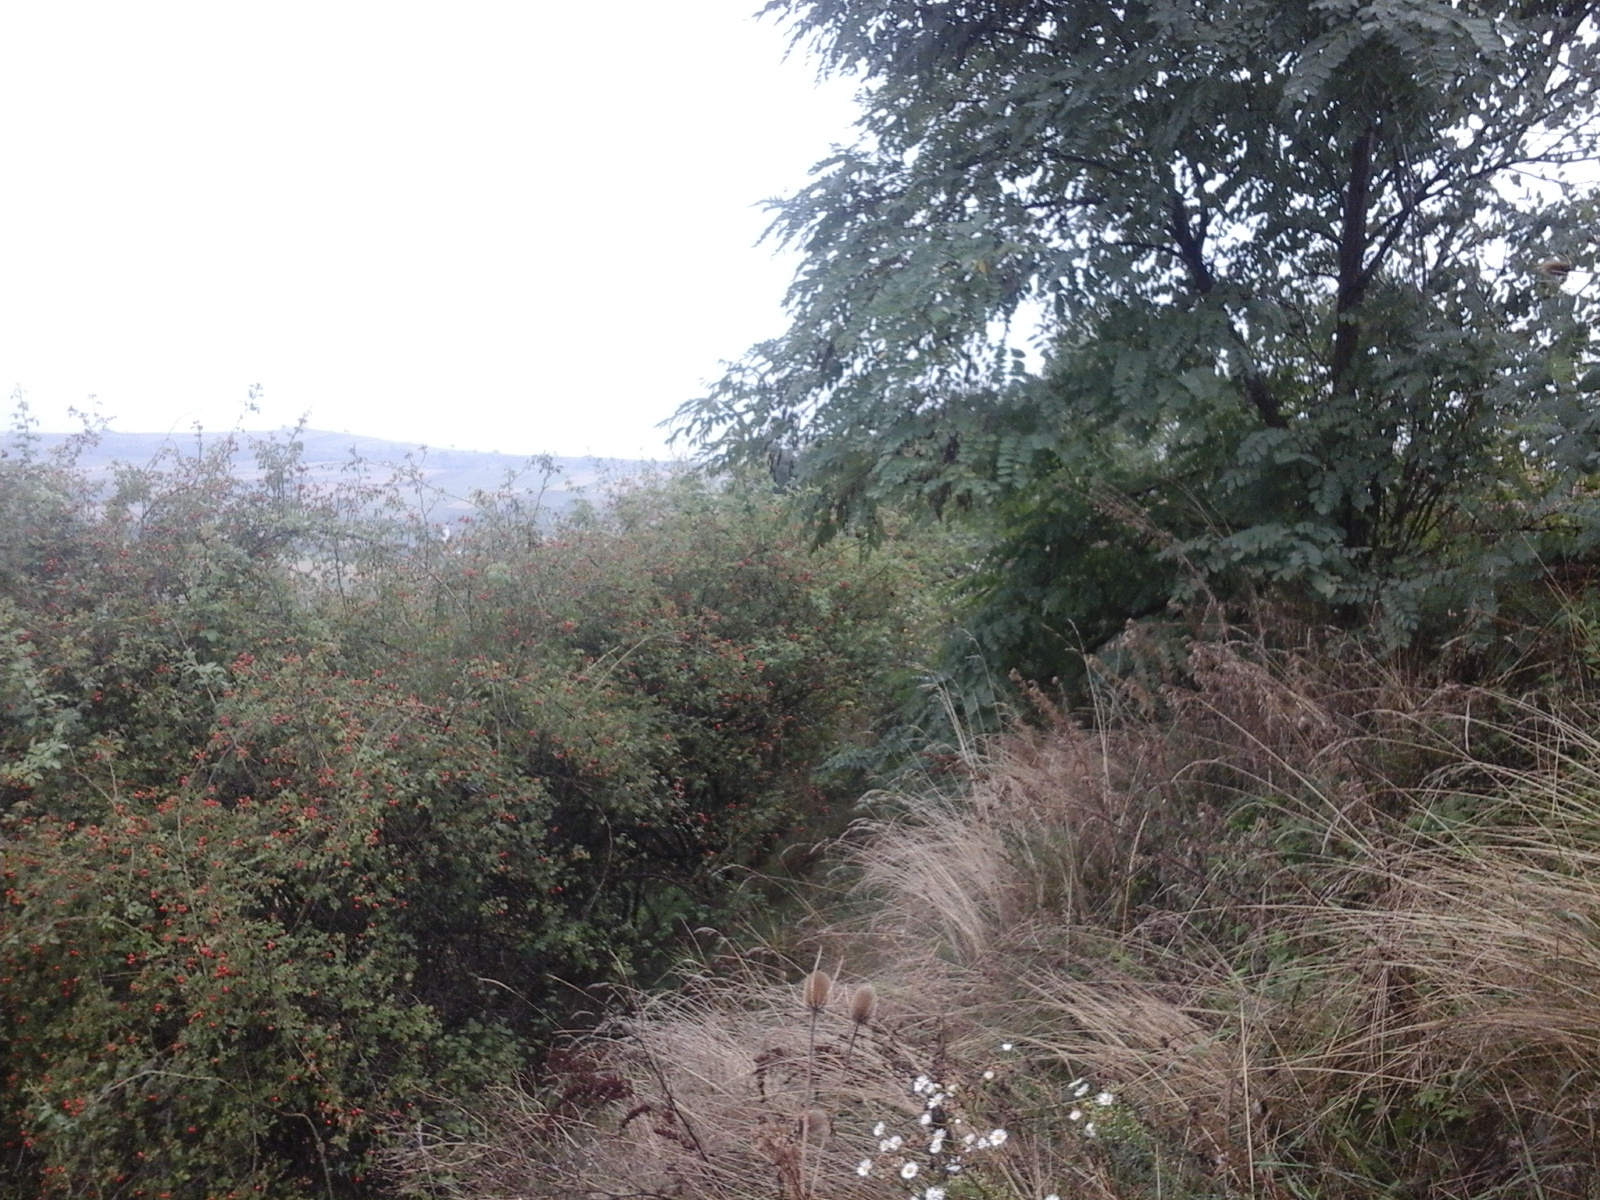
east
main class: Shrubland
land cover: Shrubland with sparse tree cover
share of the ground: > 75 %
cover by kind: shrubs 95 %, broadleaved forest trees 5 %
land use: Fallow land
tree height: < 5 m
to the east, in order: Shrubland with sparse tree cover; Grassland without tree/shrub cover; Tracks; Broadleaved woodland; Grassland without tree/shrub cover
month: September
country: RO
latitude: 47.2313
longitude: 22.5378
